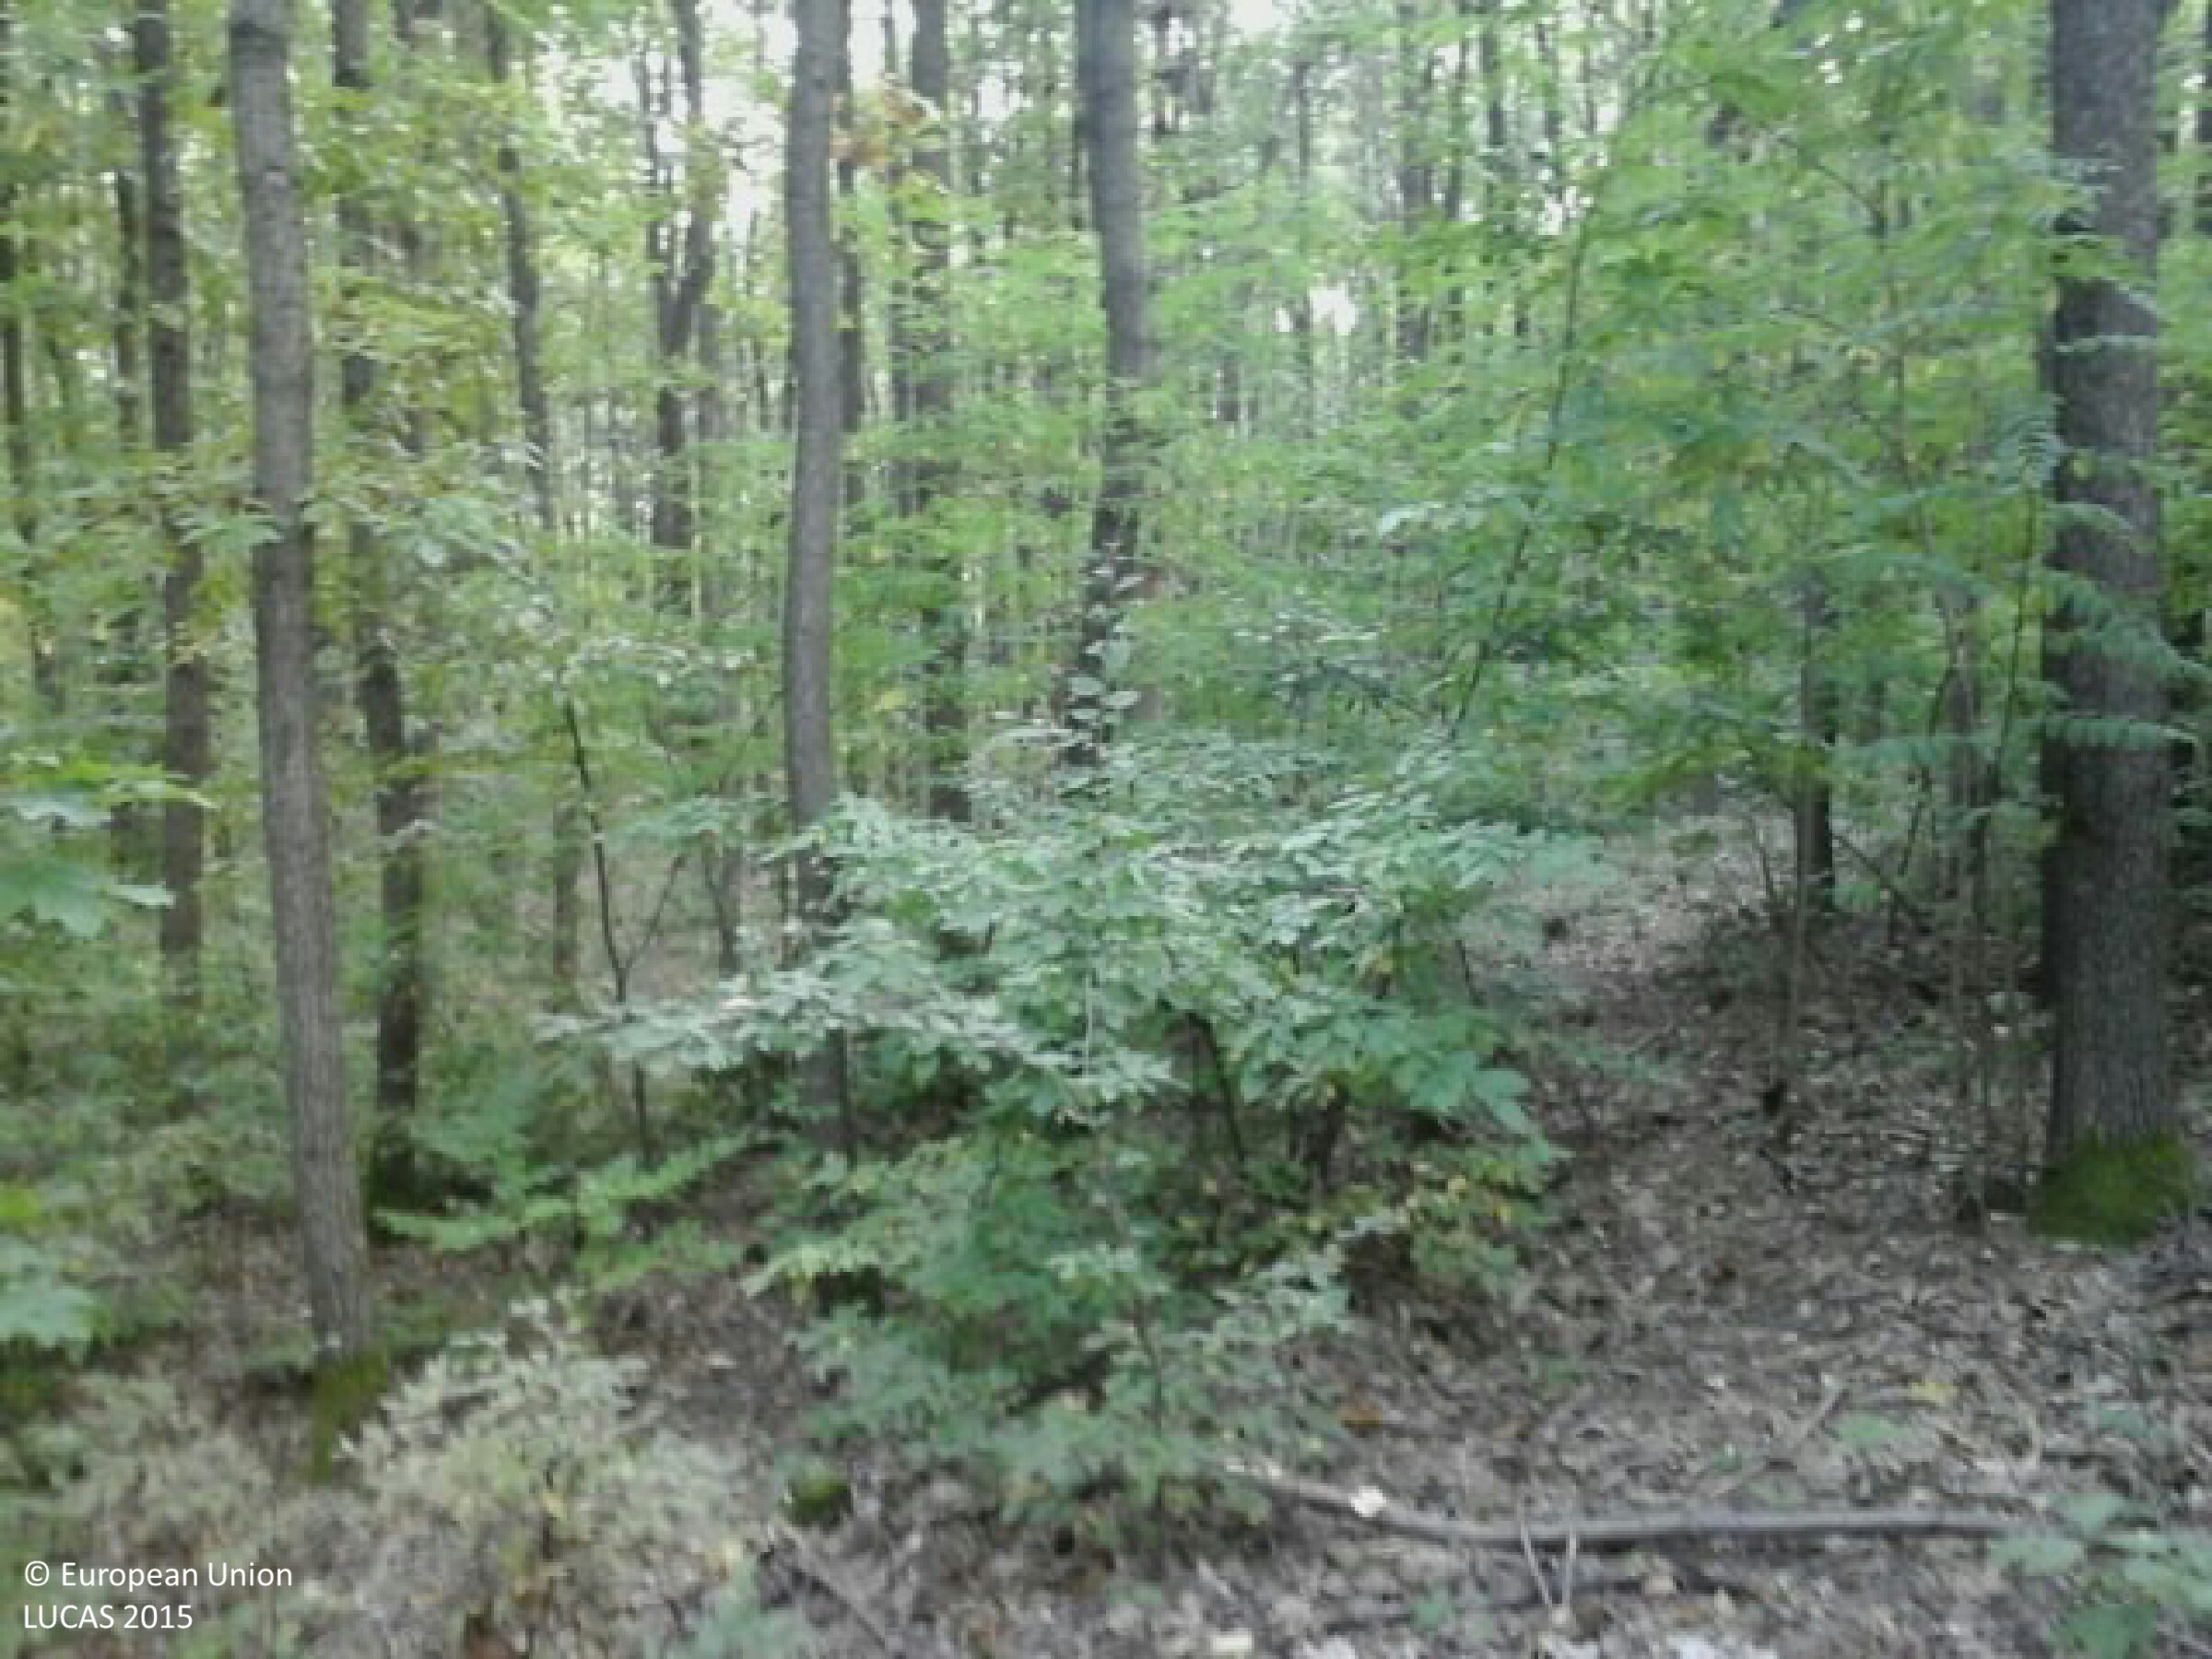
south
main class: Woodland
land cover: Broadleaved woodland
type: mesophytic deciduous forest
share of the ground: > 75 %
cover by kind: broadleaved forest trees 100 %
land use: Forestry
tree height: > 5 m
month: September
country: HU
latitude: 48.1438
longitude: 19.8516
